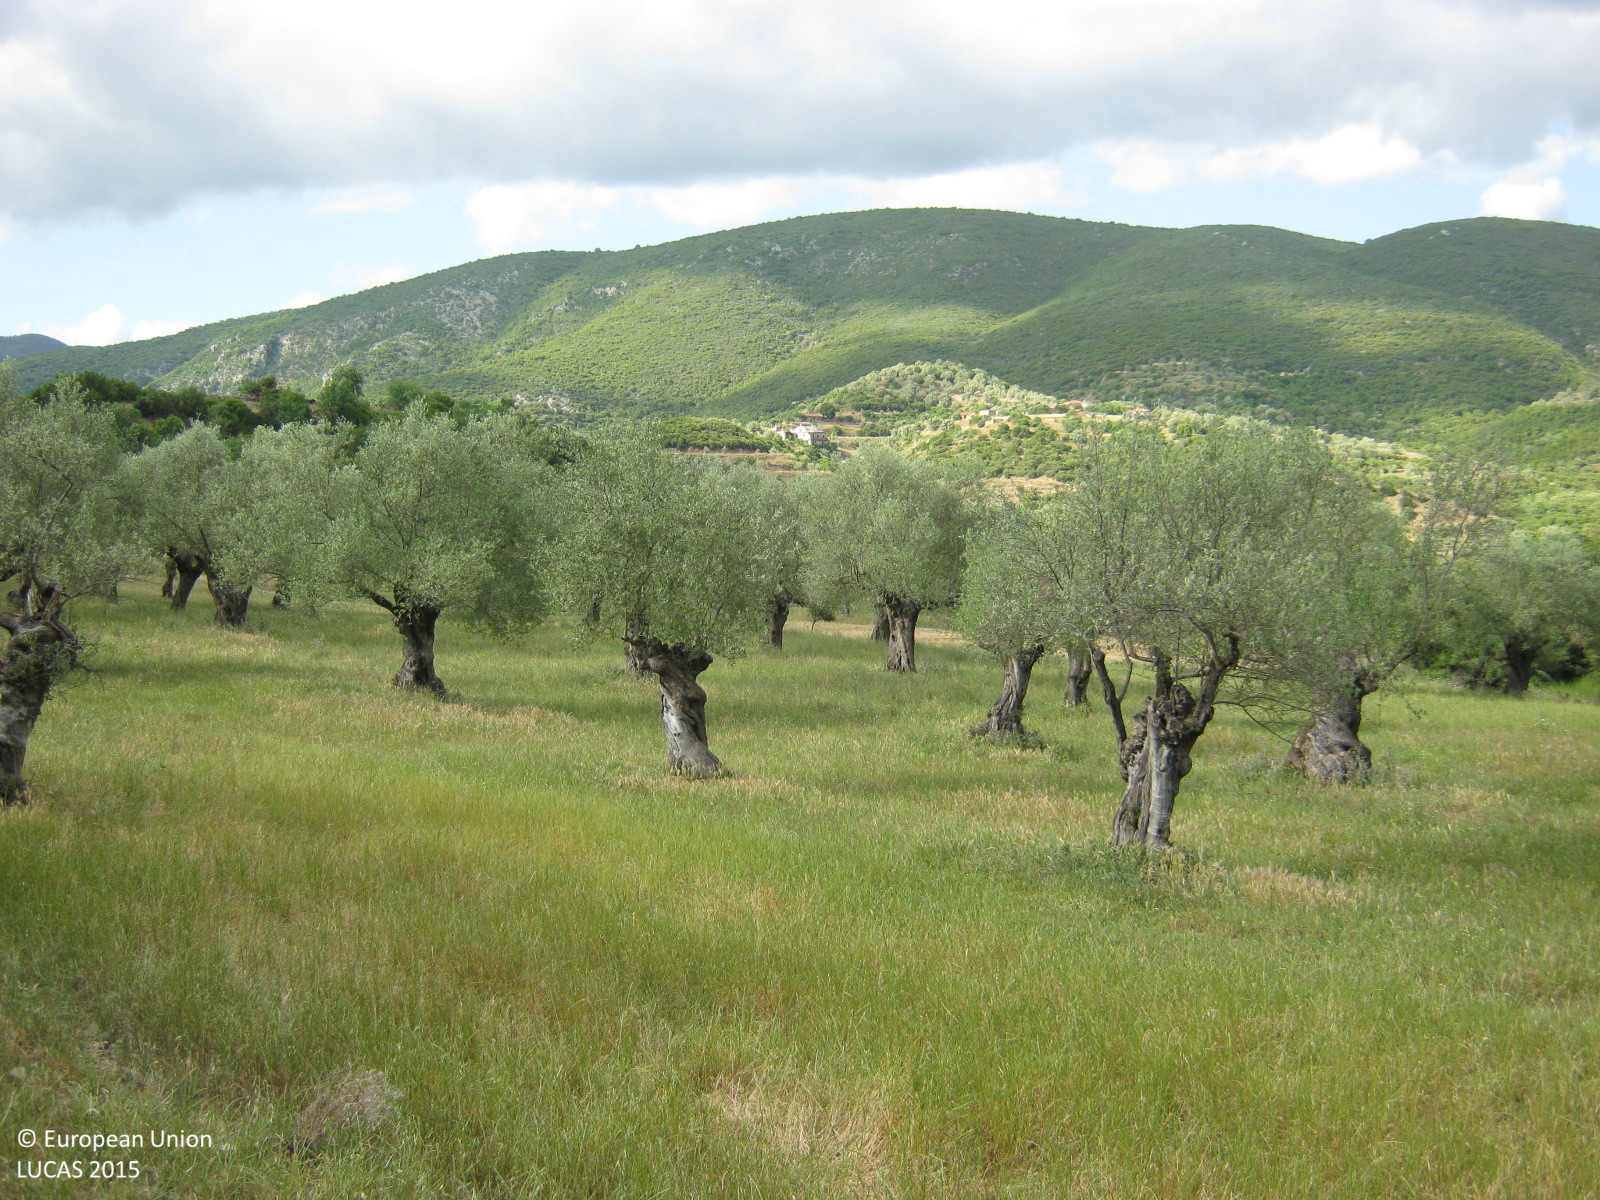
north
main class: Shrubland
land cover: Shrubland with sparse tree cover
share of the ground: > 75 %
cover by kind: shrubs 85 %, herbaceous plants 10 %, broadleaved forest trees 5 %
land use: Semi-natural and natural areas not in use
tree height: < 5 m
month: May
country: GR
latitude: 37.2568
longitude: 22.3040
